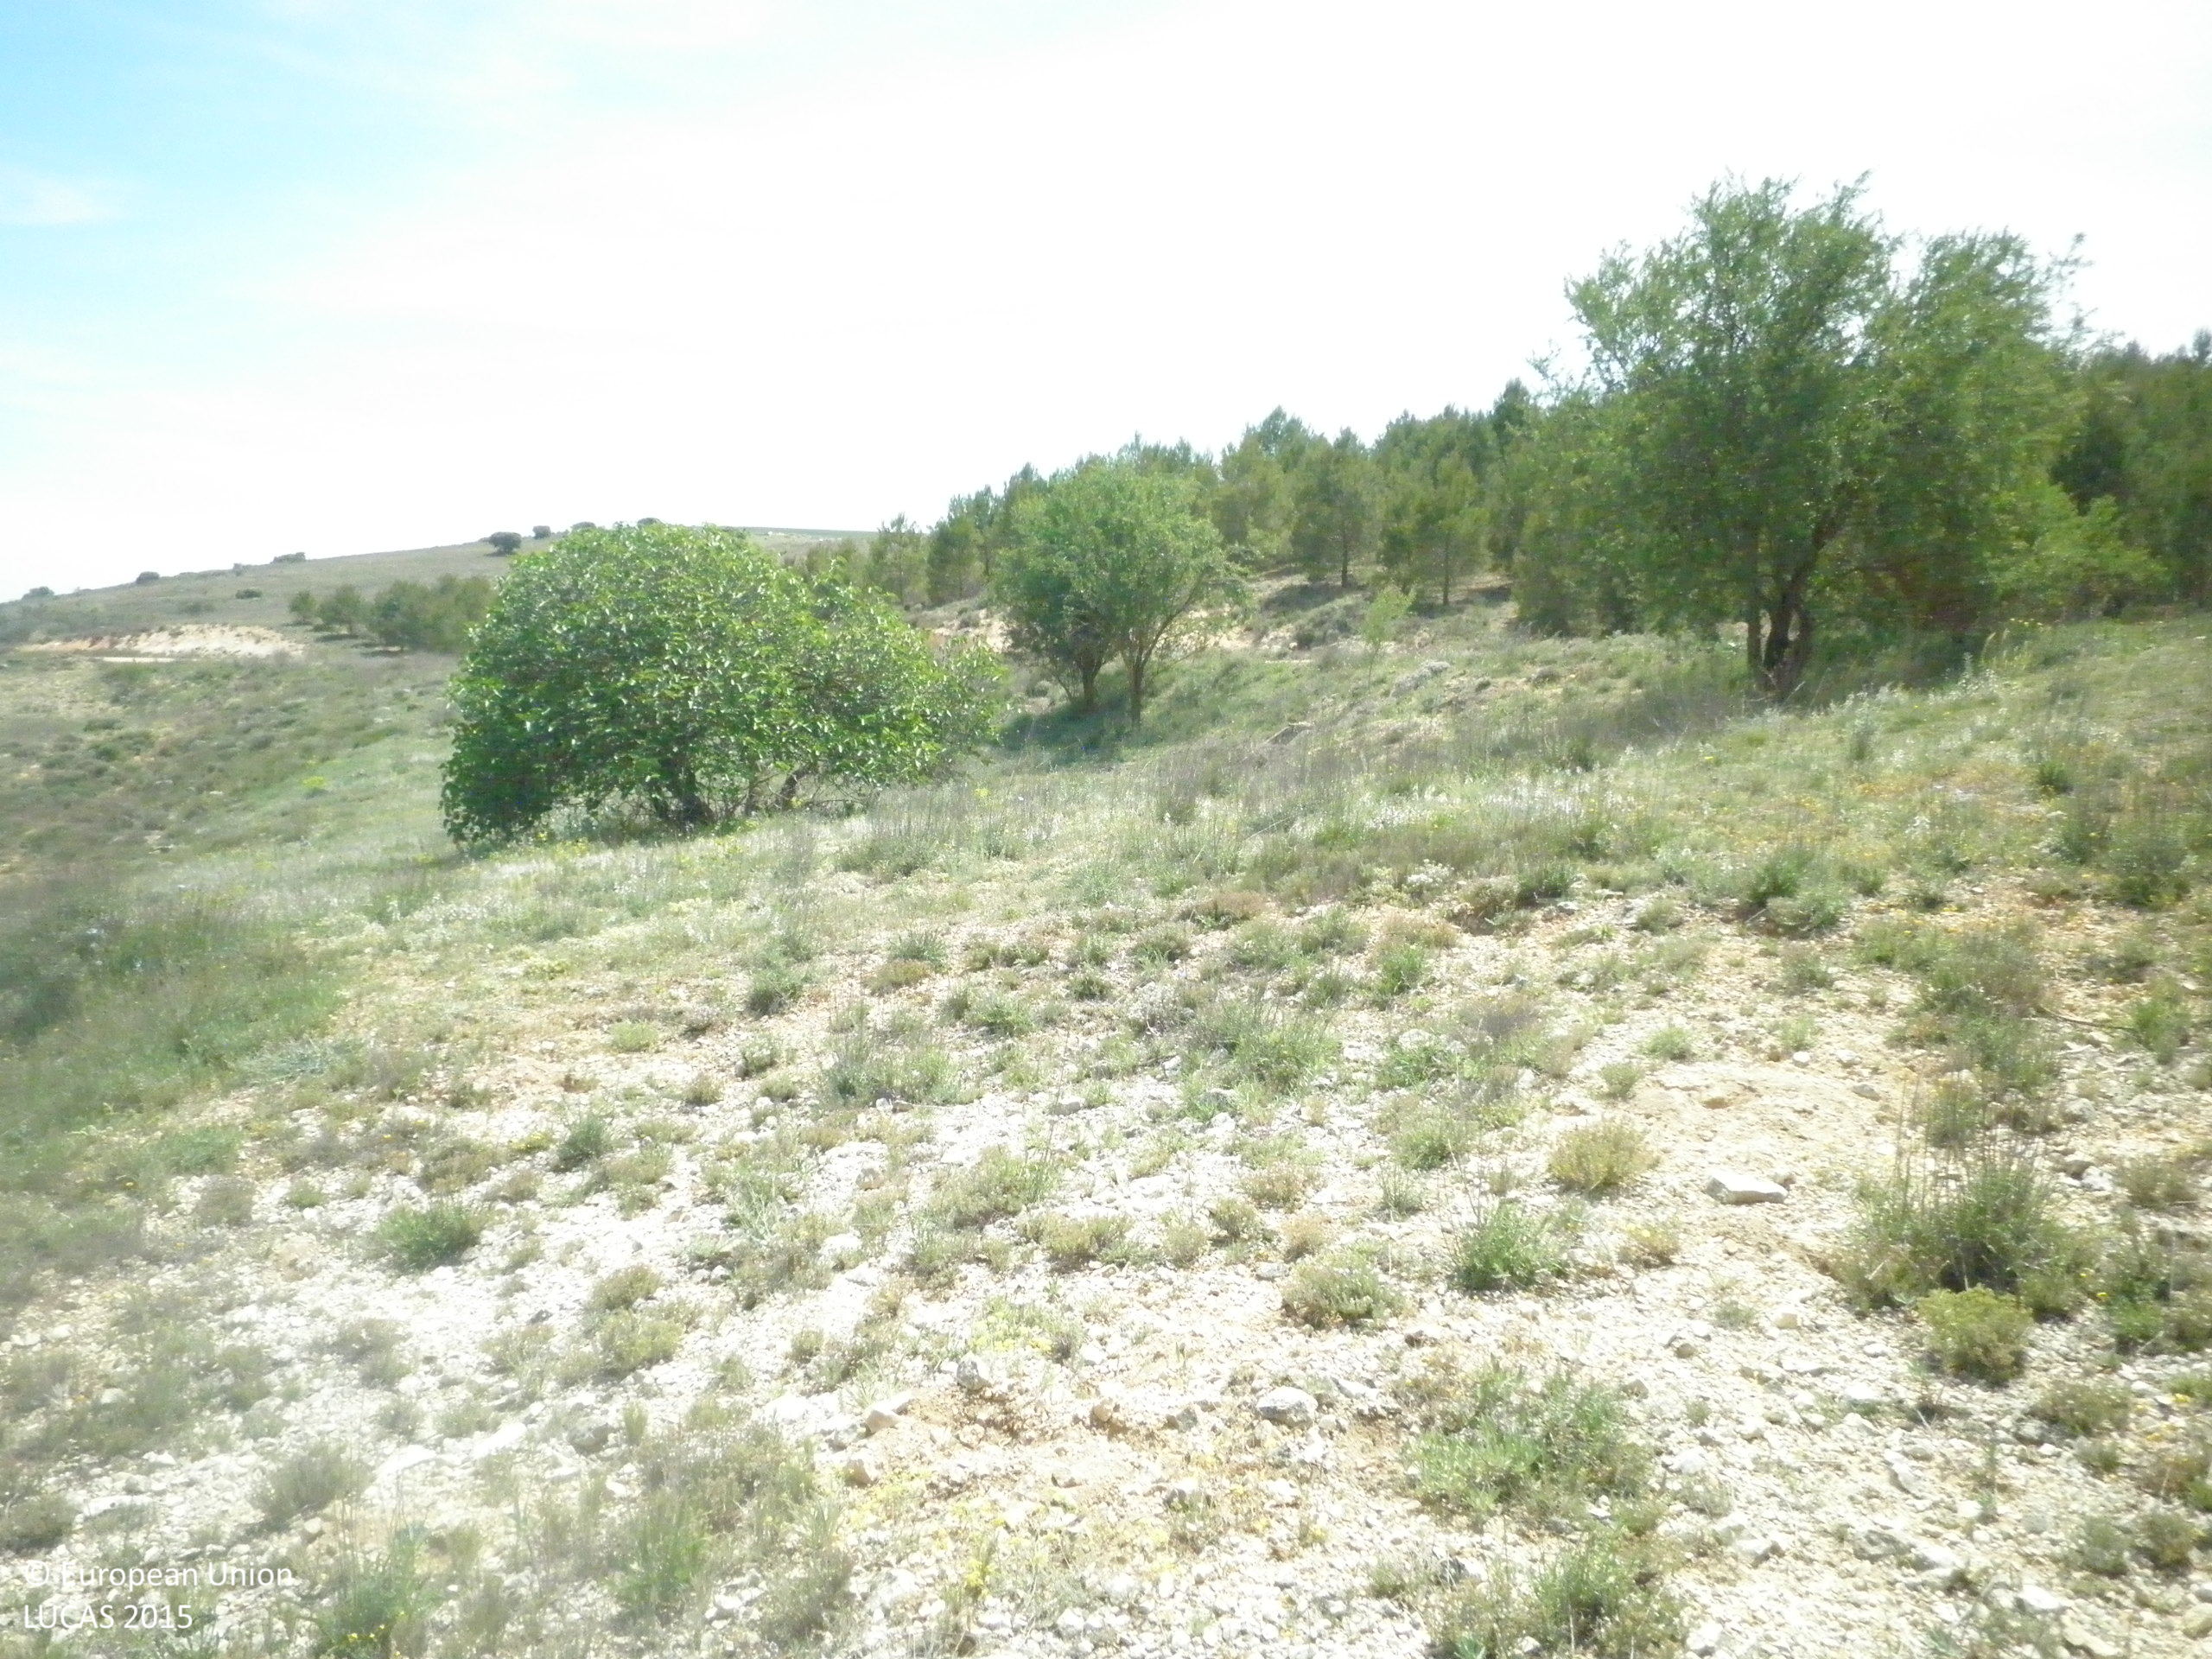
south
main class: Shrubland
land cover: Shrubland with sparse tree cover
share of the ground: 50 - 75 %
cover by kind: unconsolidated bare surface 45 %, shrubs 30 %, herbaceous plants 20 %, broadleaved forest trees 5 %
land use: Semi-natural and natural areas not in use
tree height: < 5 m
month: May
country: ES
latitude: 39.5824
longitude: -2.7174
